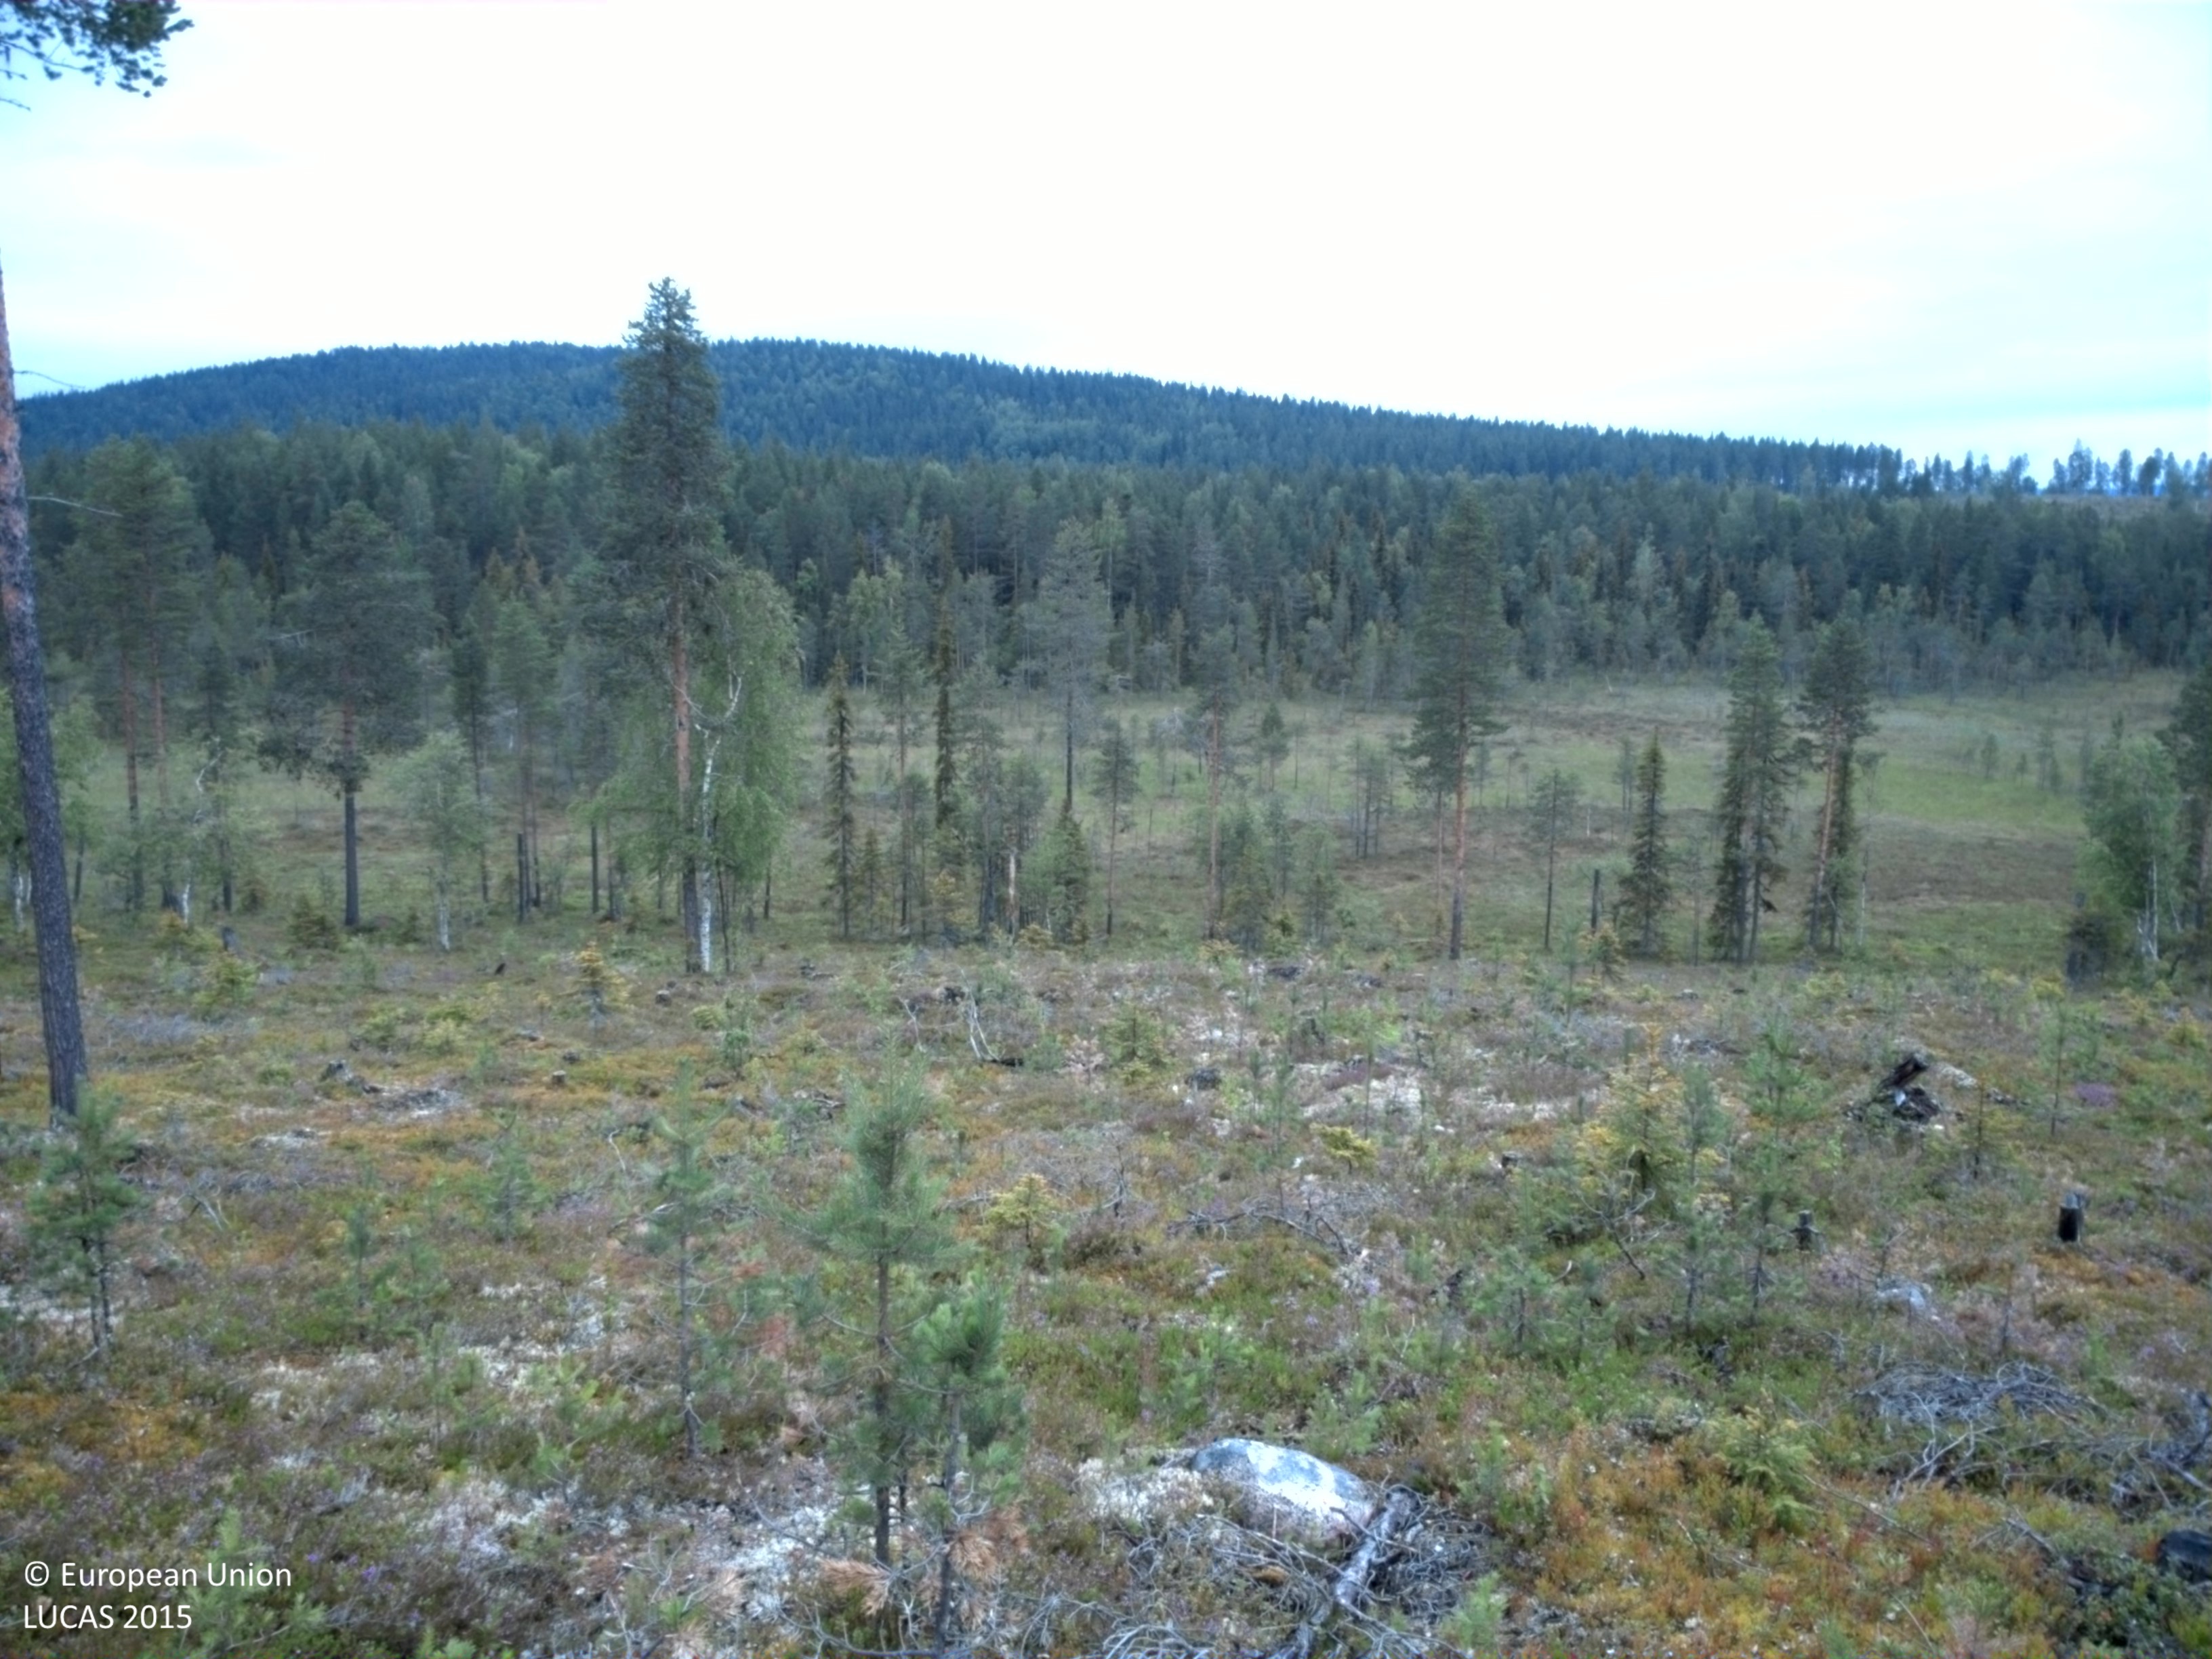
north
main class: Woodland
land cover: Pine dominated coniferous woodland
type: boreal forest
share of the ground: 10 - 25 %
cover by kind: shrubs 80 %, coniferous forest trees 10 %, lichens and mosses 10 %
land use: Forestry
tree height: < 5 m
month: August
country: SE
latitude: 66.4591
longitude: 20.5247
